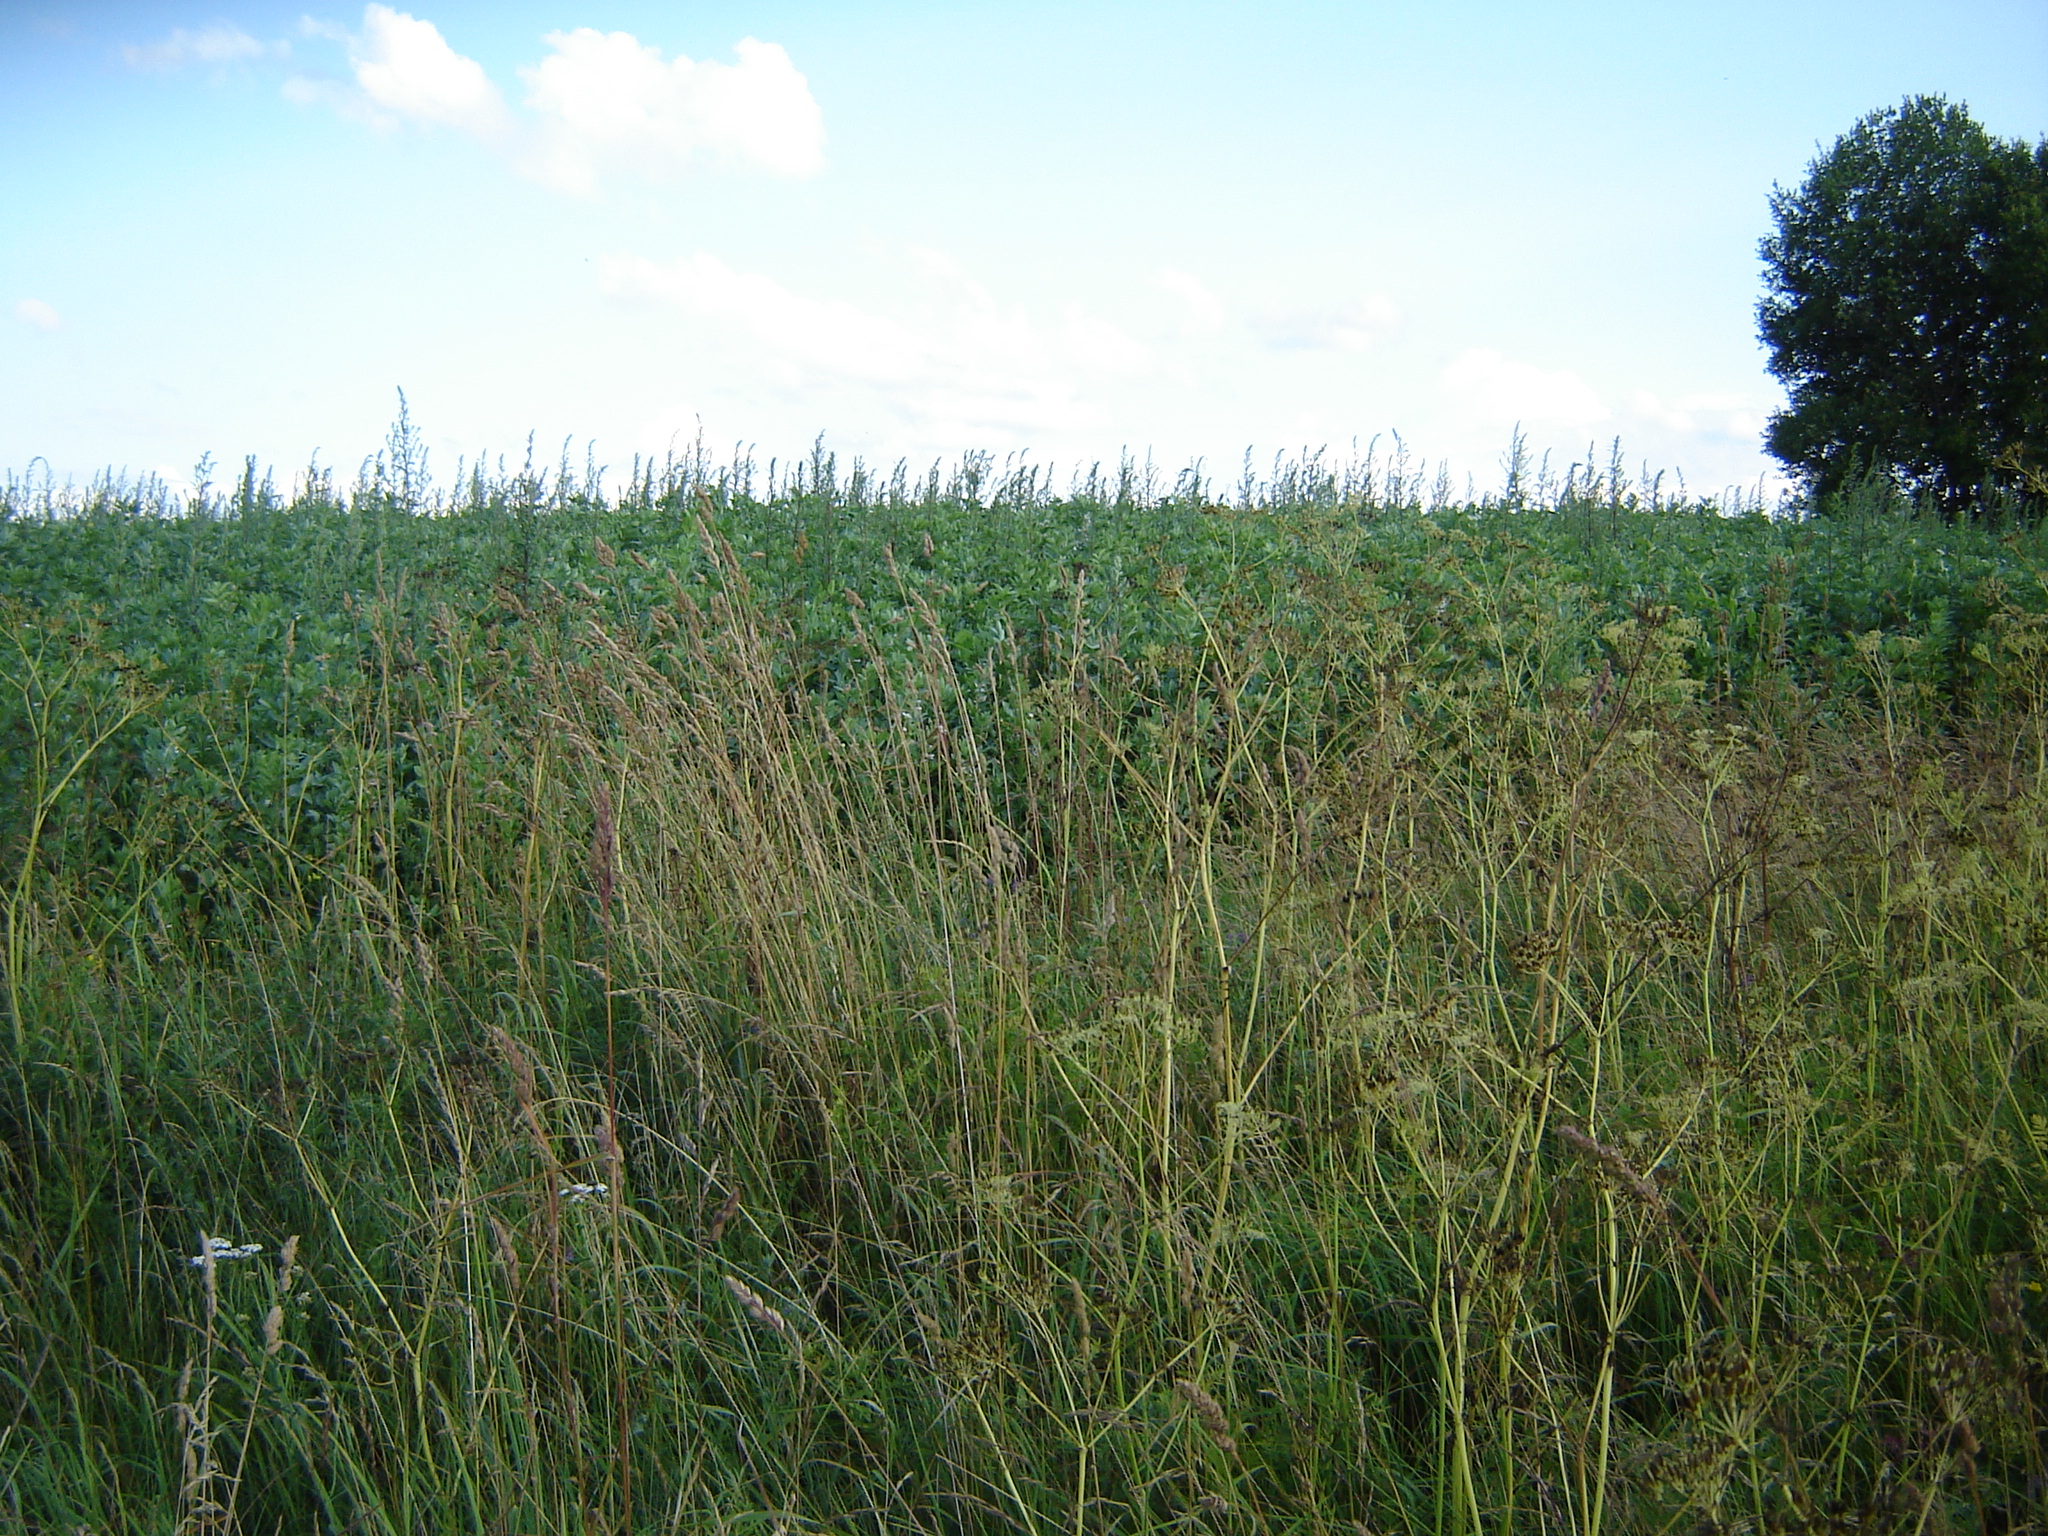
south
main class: Grassland
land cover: Spontaneously vegetated surfaces
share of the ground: > 75 %
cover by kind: herbaceous plants 100 %
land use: Fallow land
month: July
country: LT
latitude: 55.3649
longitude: 25.5073
